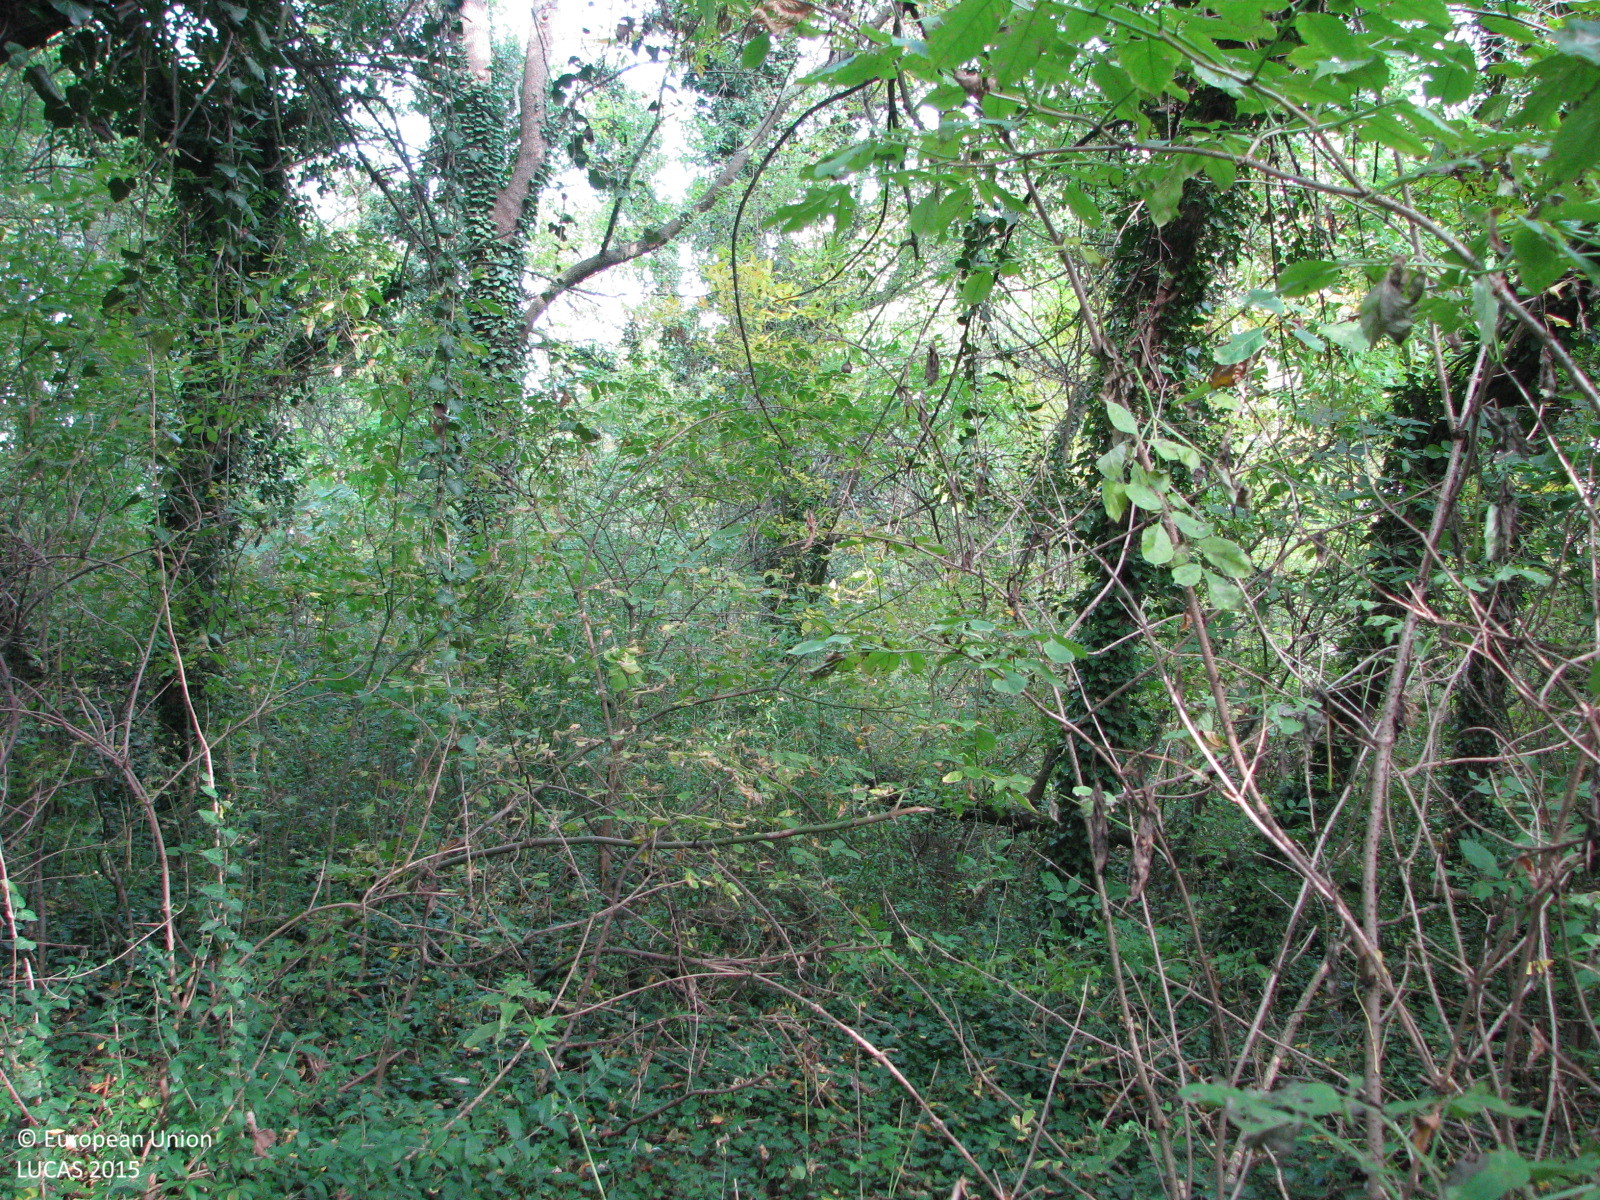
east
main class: Woodland
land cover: Broadleaved woodland
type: mesophytic deciduous forest
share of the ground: 50 - 75 %
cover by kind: broadleaved forest trees 60 %, shrubs 30 %, herbaceous plants 10 %
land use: Forestry
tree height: > 5 m
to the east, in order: Broadleaved woodland; Artificial constructions in urban areas
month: October
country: BG
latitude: 42.4261
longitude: 26.1885
